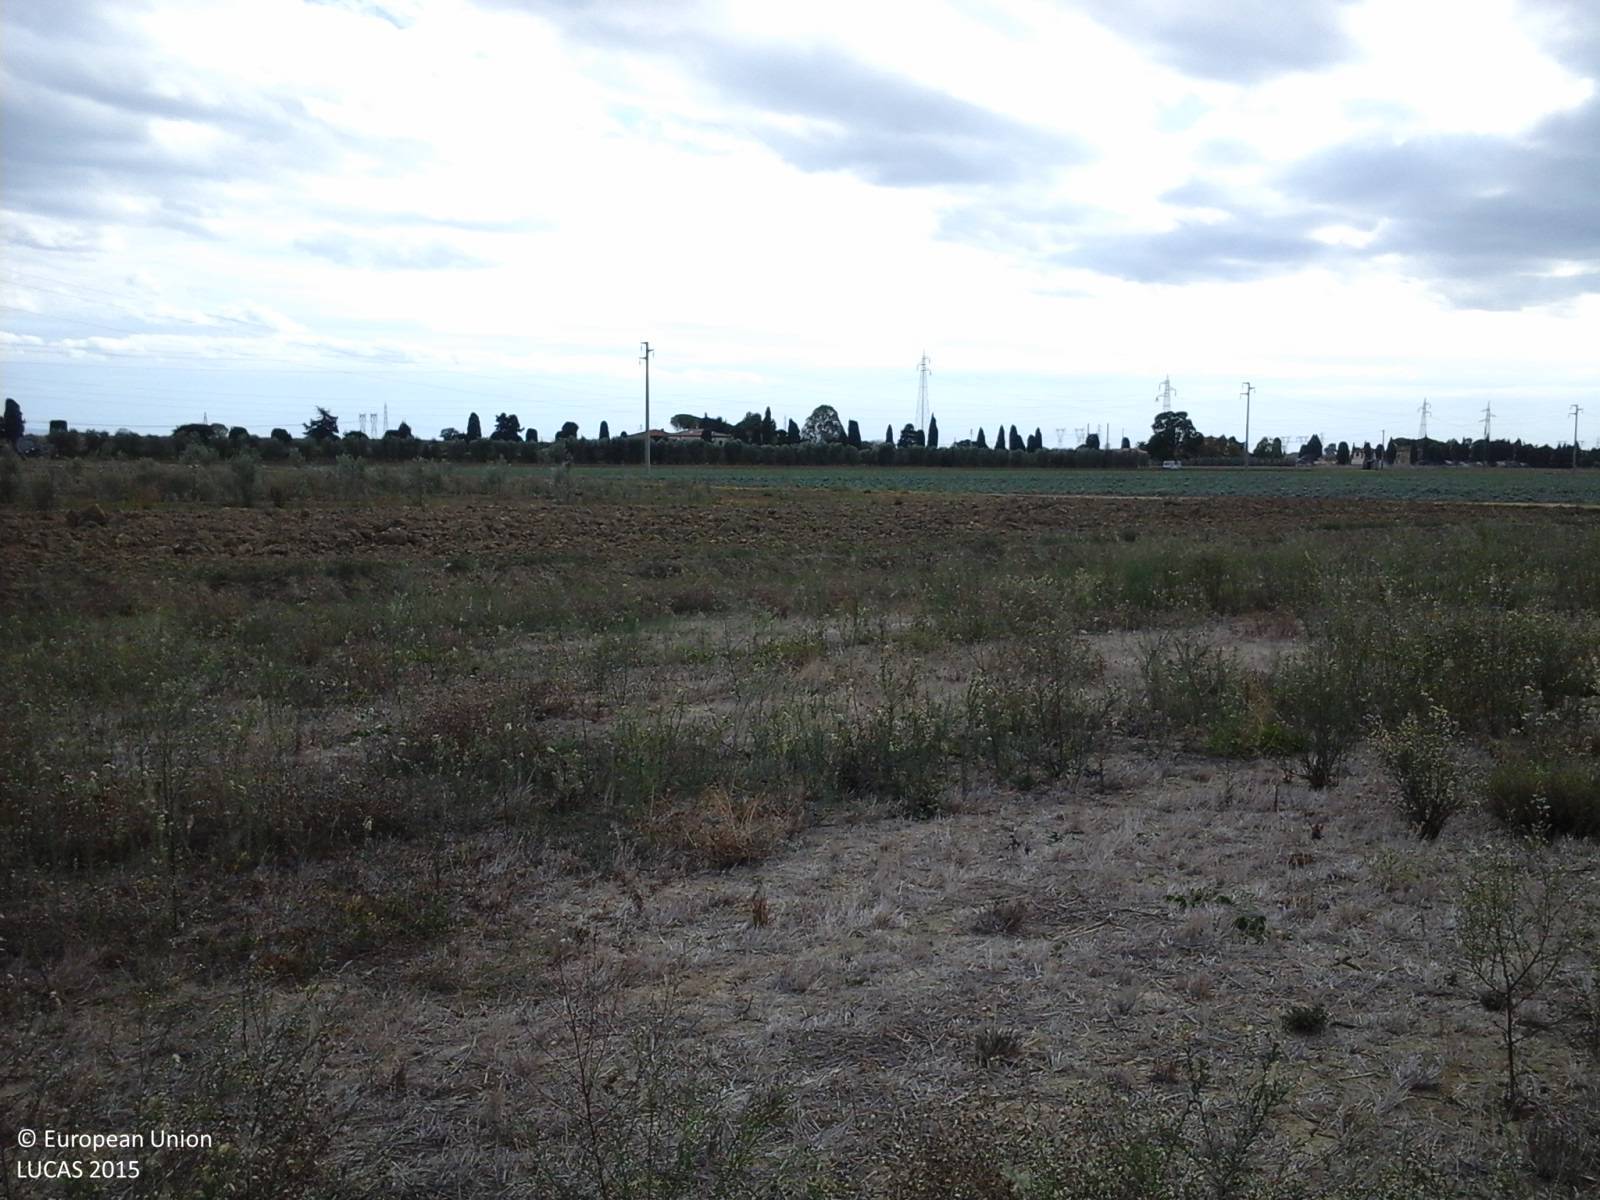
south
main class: Grassland
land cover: Spontaneously vegetated surfaces
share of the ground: > 75 %
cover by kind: herbaceous plants 100 %
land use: Fallow land
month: September
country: IT
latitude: 43.0313
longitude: 10.6240
